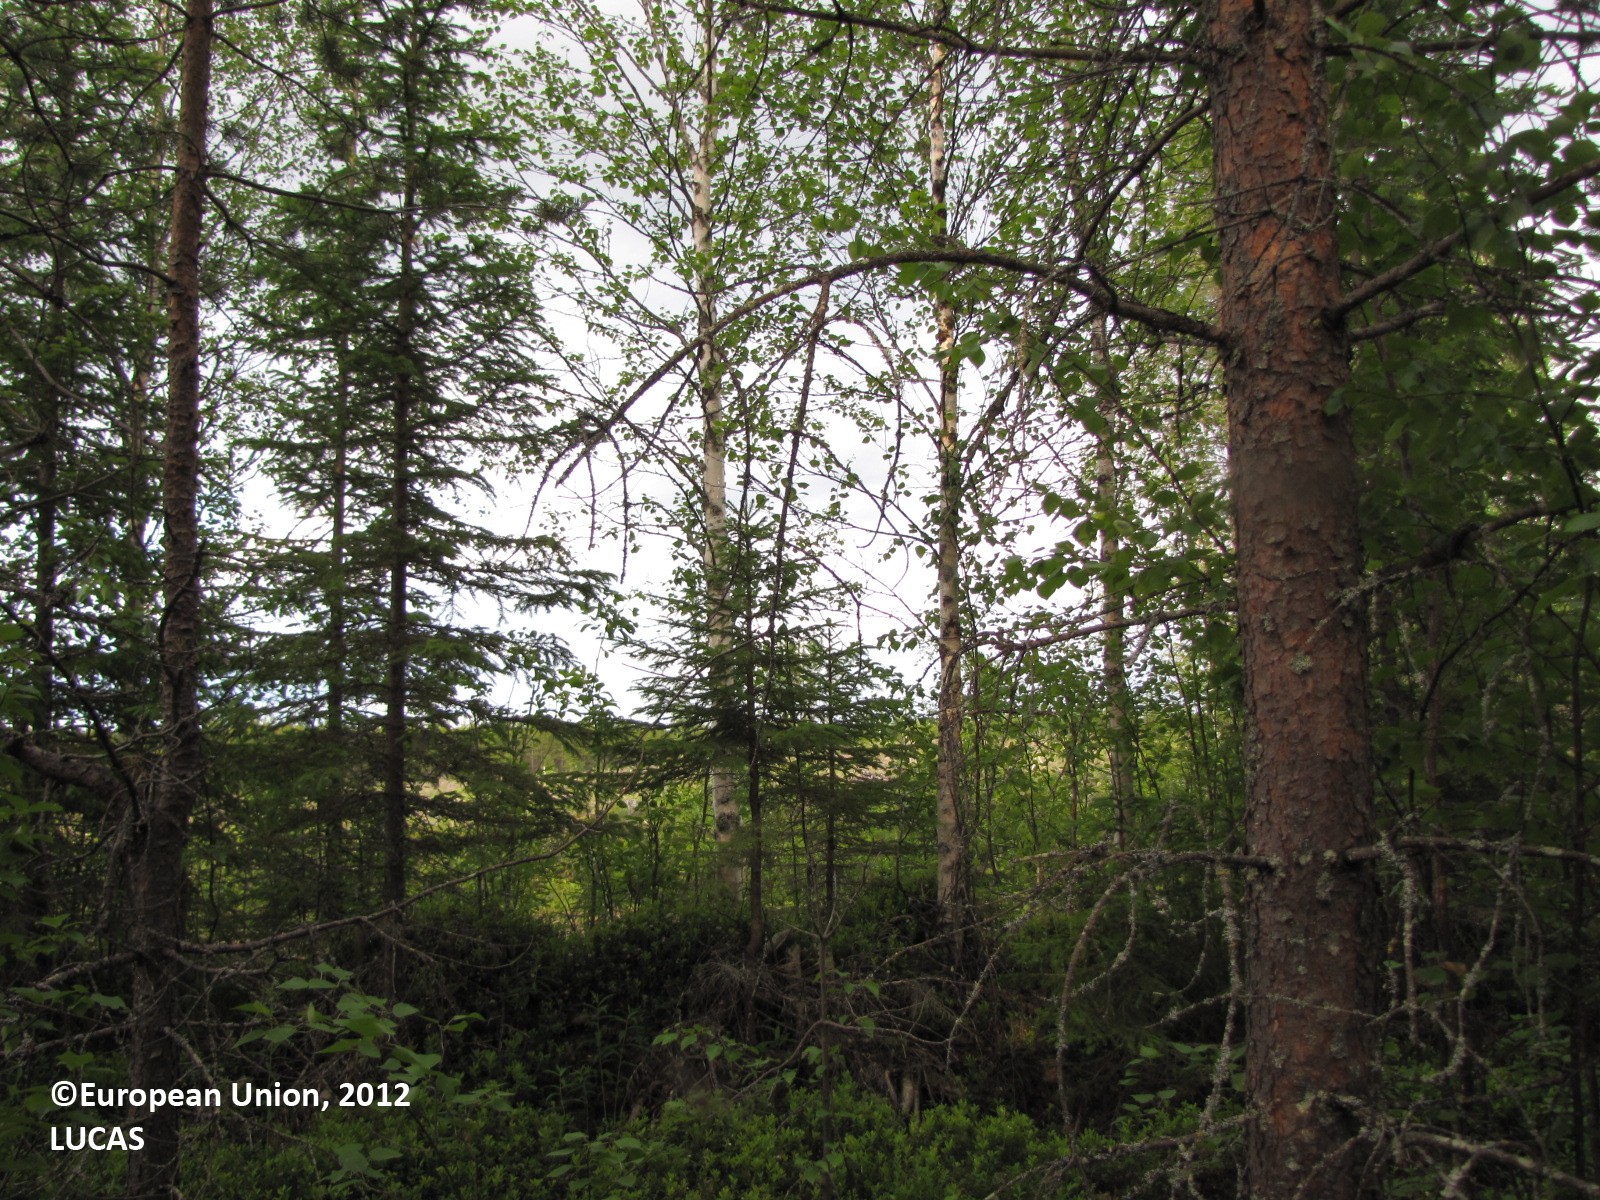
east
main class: Woodland
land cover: Pine dominated mixed woodland
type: boreal forest
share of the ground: 50 - 75 %
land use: Forestry
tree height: > 5 m
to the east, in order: Pine dominated mixed woodland; Paved roads, cycling and walking lanes; Ditches and canals; Other mixed woodland; Ditches and canals; Spruce dominated mixed woodland
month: July
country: FI
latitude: 66.3900
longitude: 25.0705
